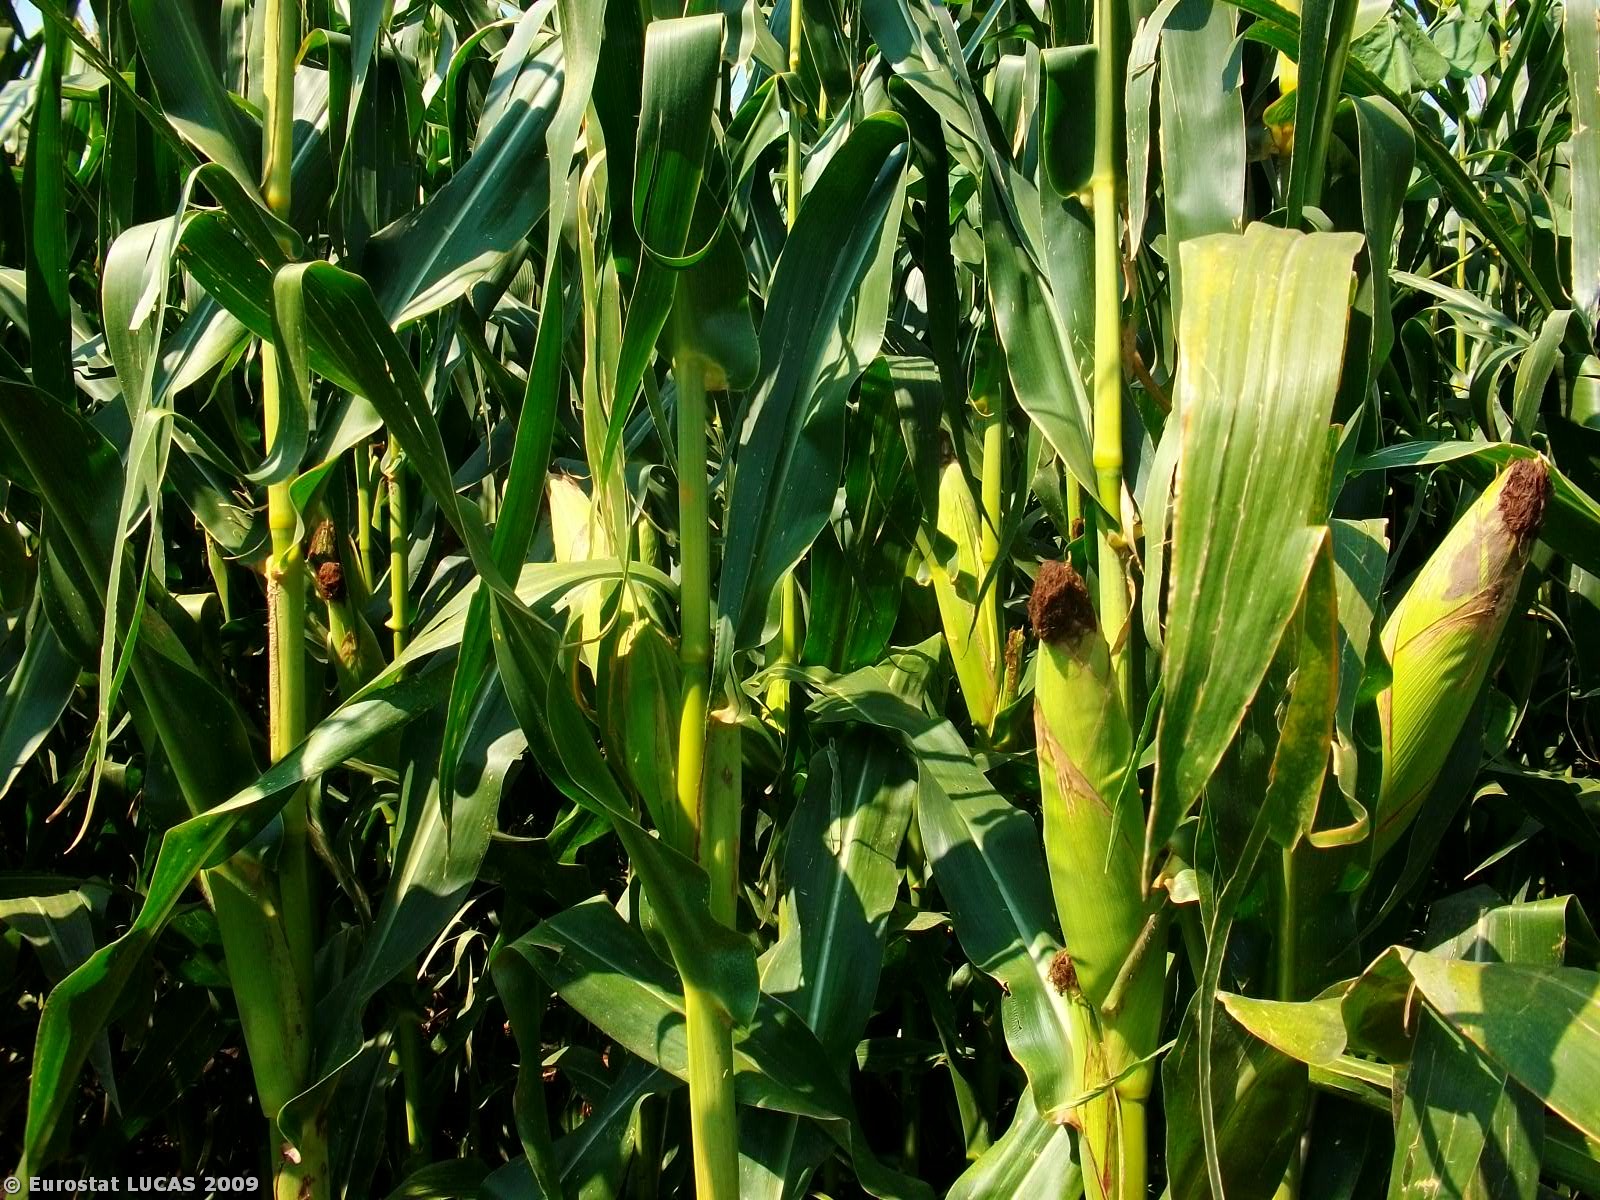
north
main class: Cropland
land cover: Maize
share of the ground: > 75 %
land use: Agriculture (excluding fallow land and kitchen gardens)
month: August
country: GR
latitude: 41.5215
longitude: 26.4350
